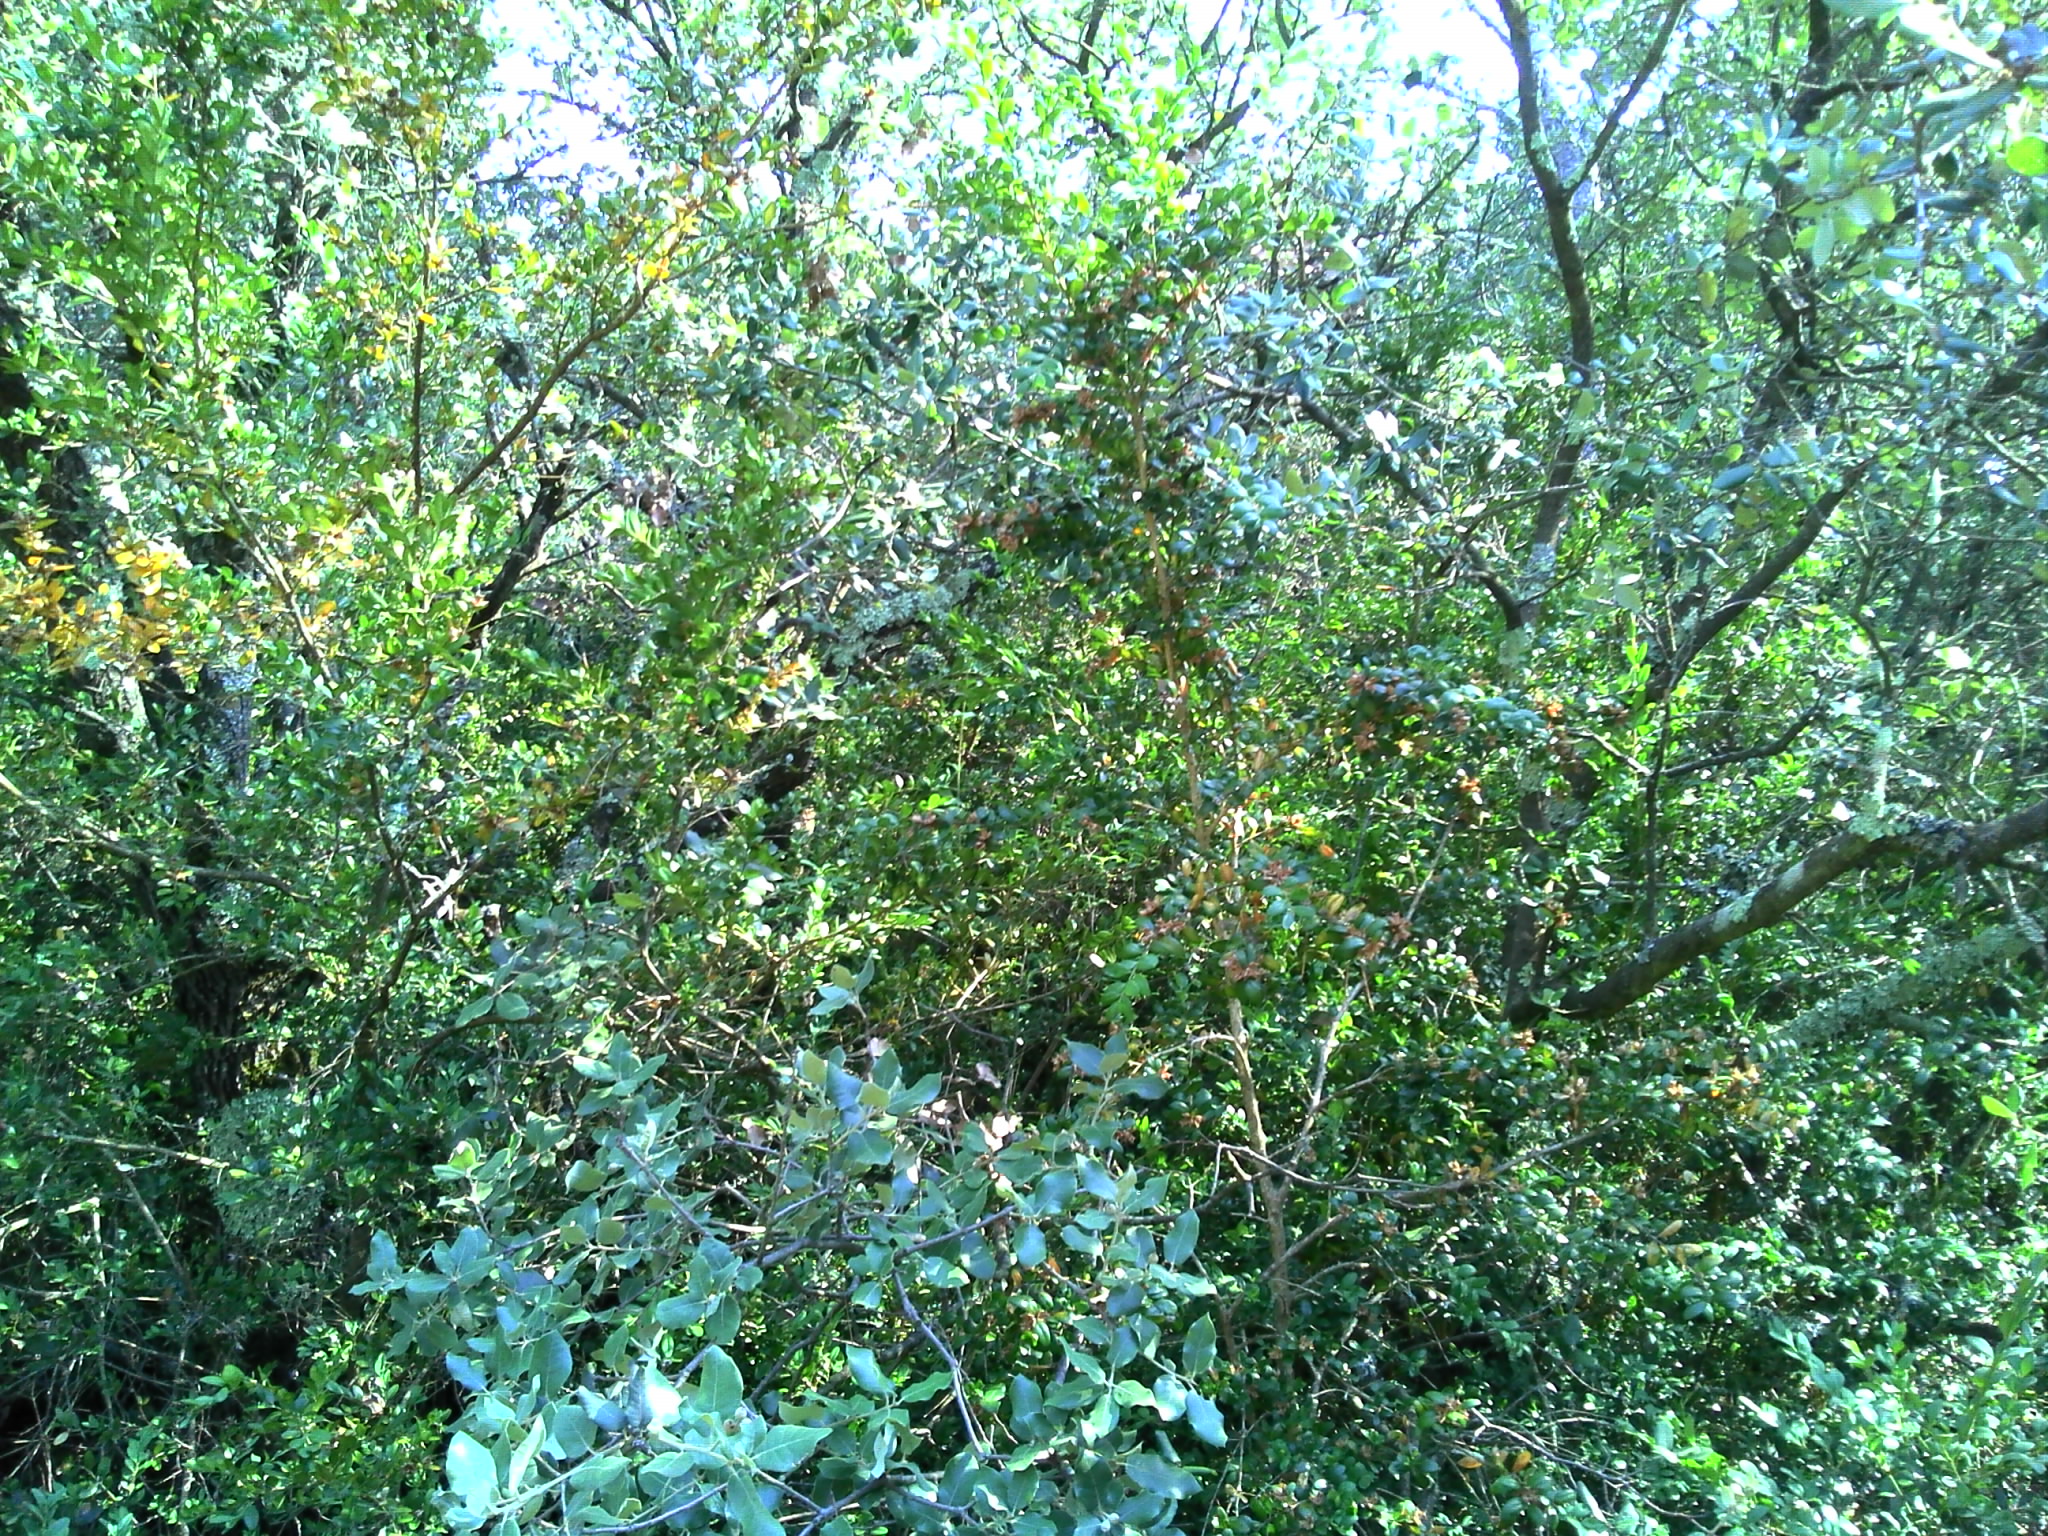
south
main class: Woodland
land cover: Pine dominated mixed woodland
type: coniferous forest of the mediterranean region
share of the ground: > 75 %
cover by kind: broadleaved forest trees 40 %, coniferous forest trees 30 %, herbaceous plants 20 %, shrubs 5 %, consolidated bare surface 5 %
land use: Semi-natural and natural areas not in use
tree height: > 5 m
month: August
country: FR
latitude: 44.0308
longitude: 4.6305
